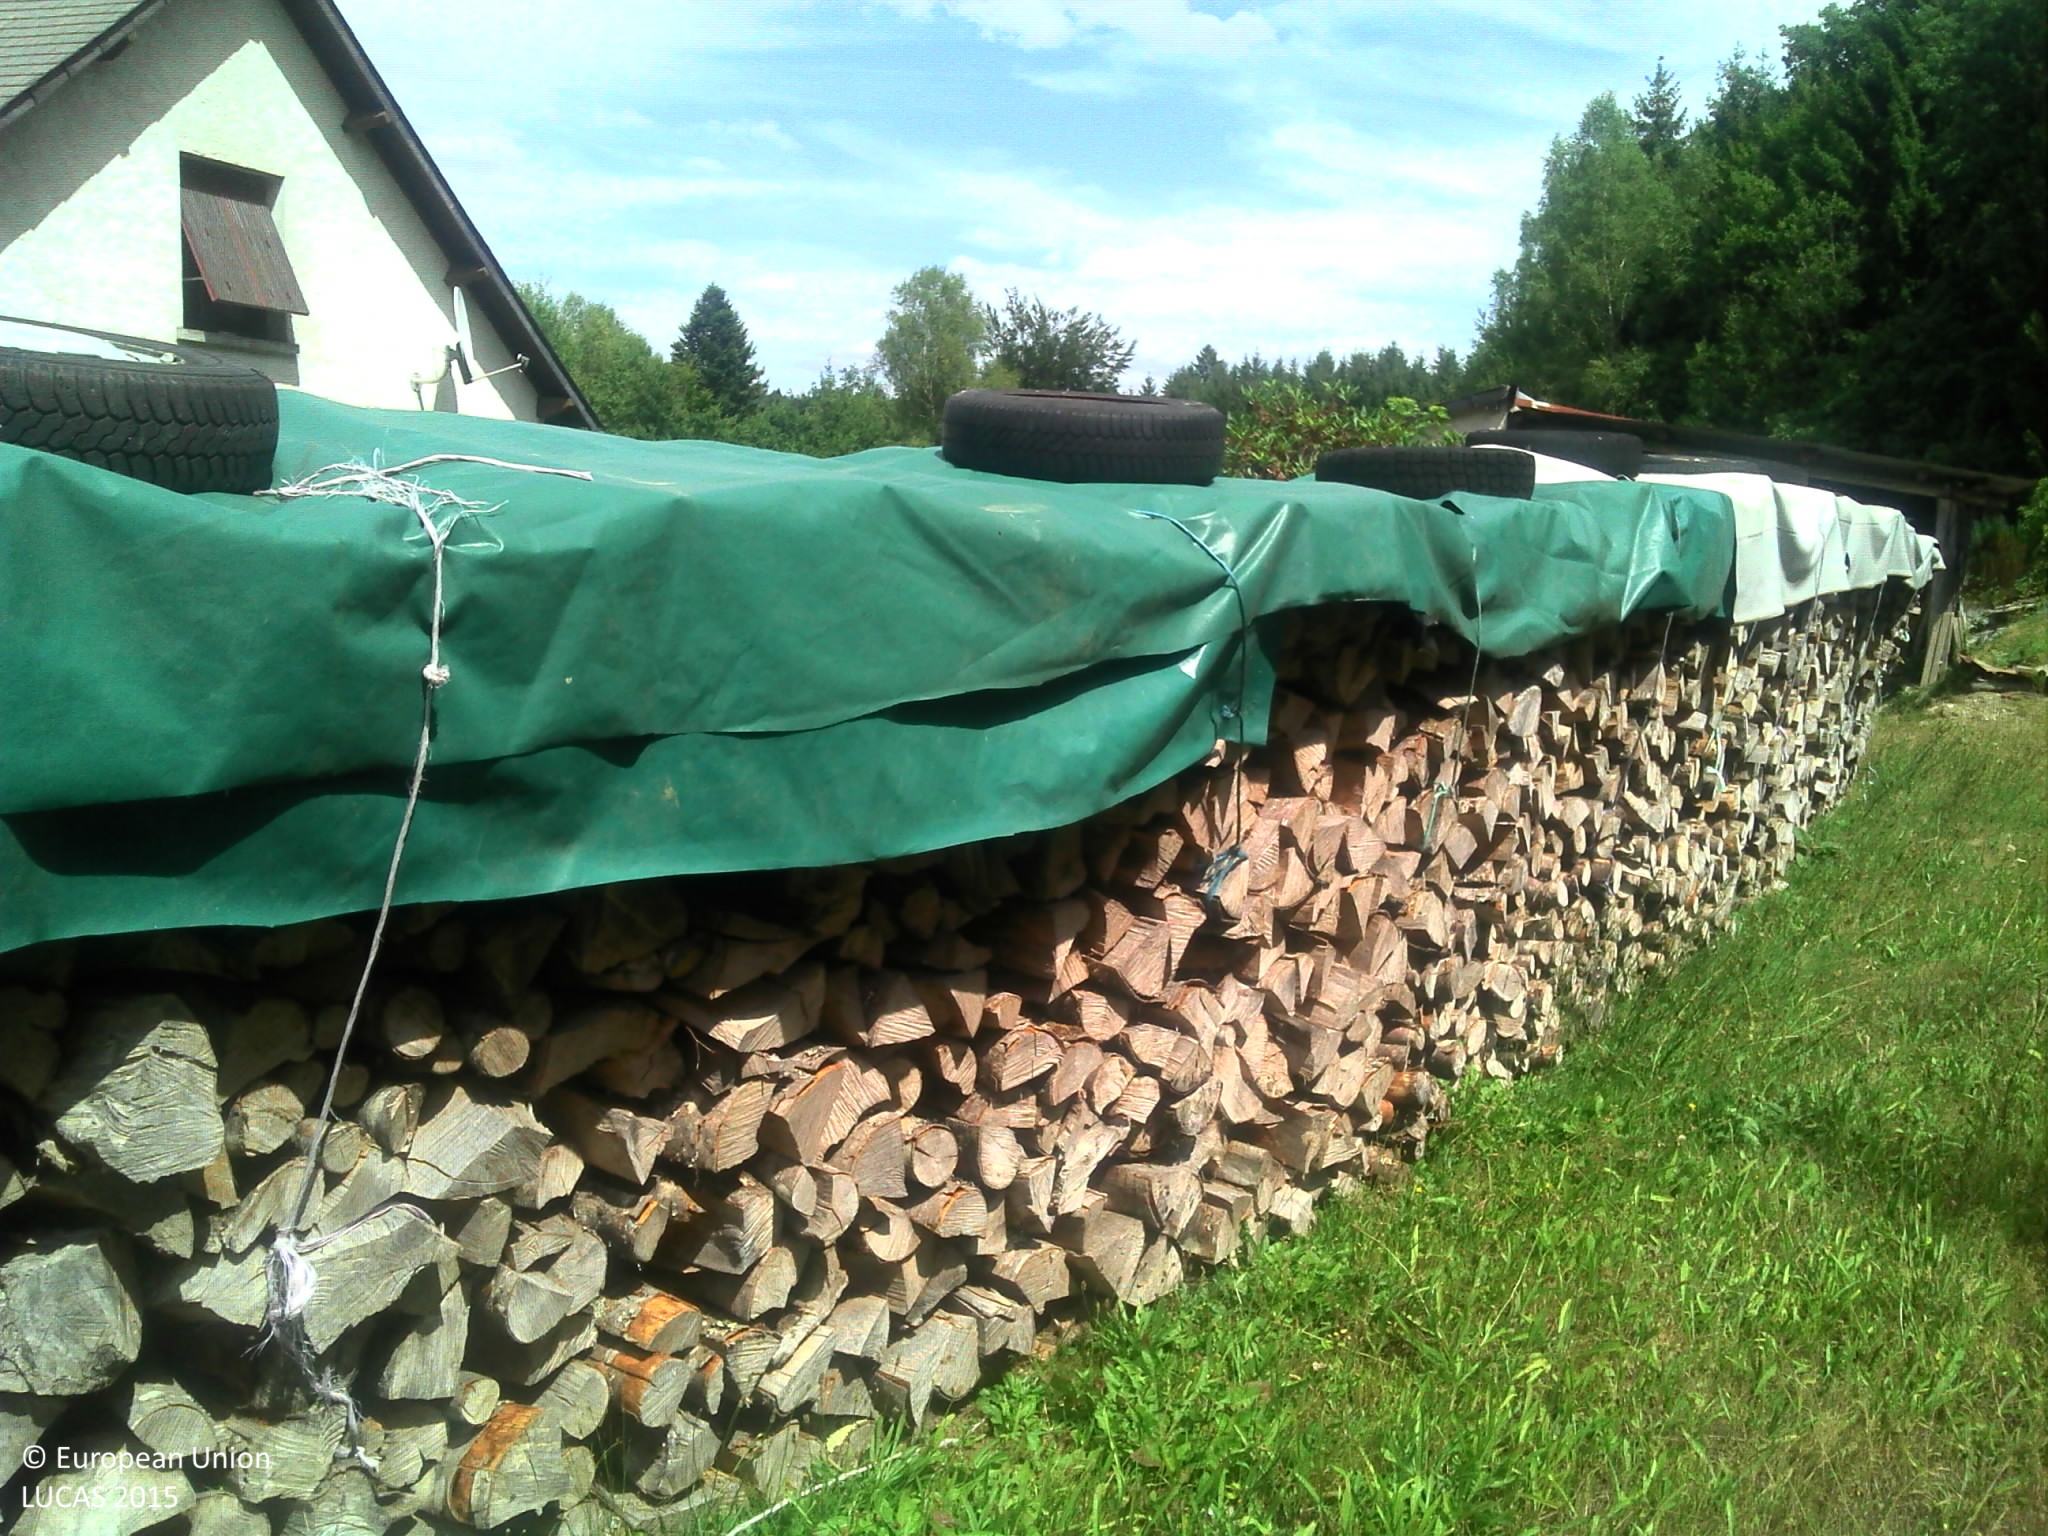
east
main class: Grassland
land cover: Grassland without tree/shrub cover
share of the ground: > 75 %
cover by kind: herbaceous plants 95 %, shrubs 5 %
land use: Forestry
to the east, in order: Grassland without tree/shrub cover; Artificial constructions in urban areas; Shrubland without tree cover; Fences; Grassland without tree/shrub cover; Pine dominated mixed woodland; Grassland without tree/shrub cover; Pine dominated mixed woodland; Electric lines; Spontaneously vegetated surfaces
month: July
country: FR
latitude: 45.6395
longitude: 1.8225
